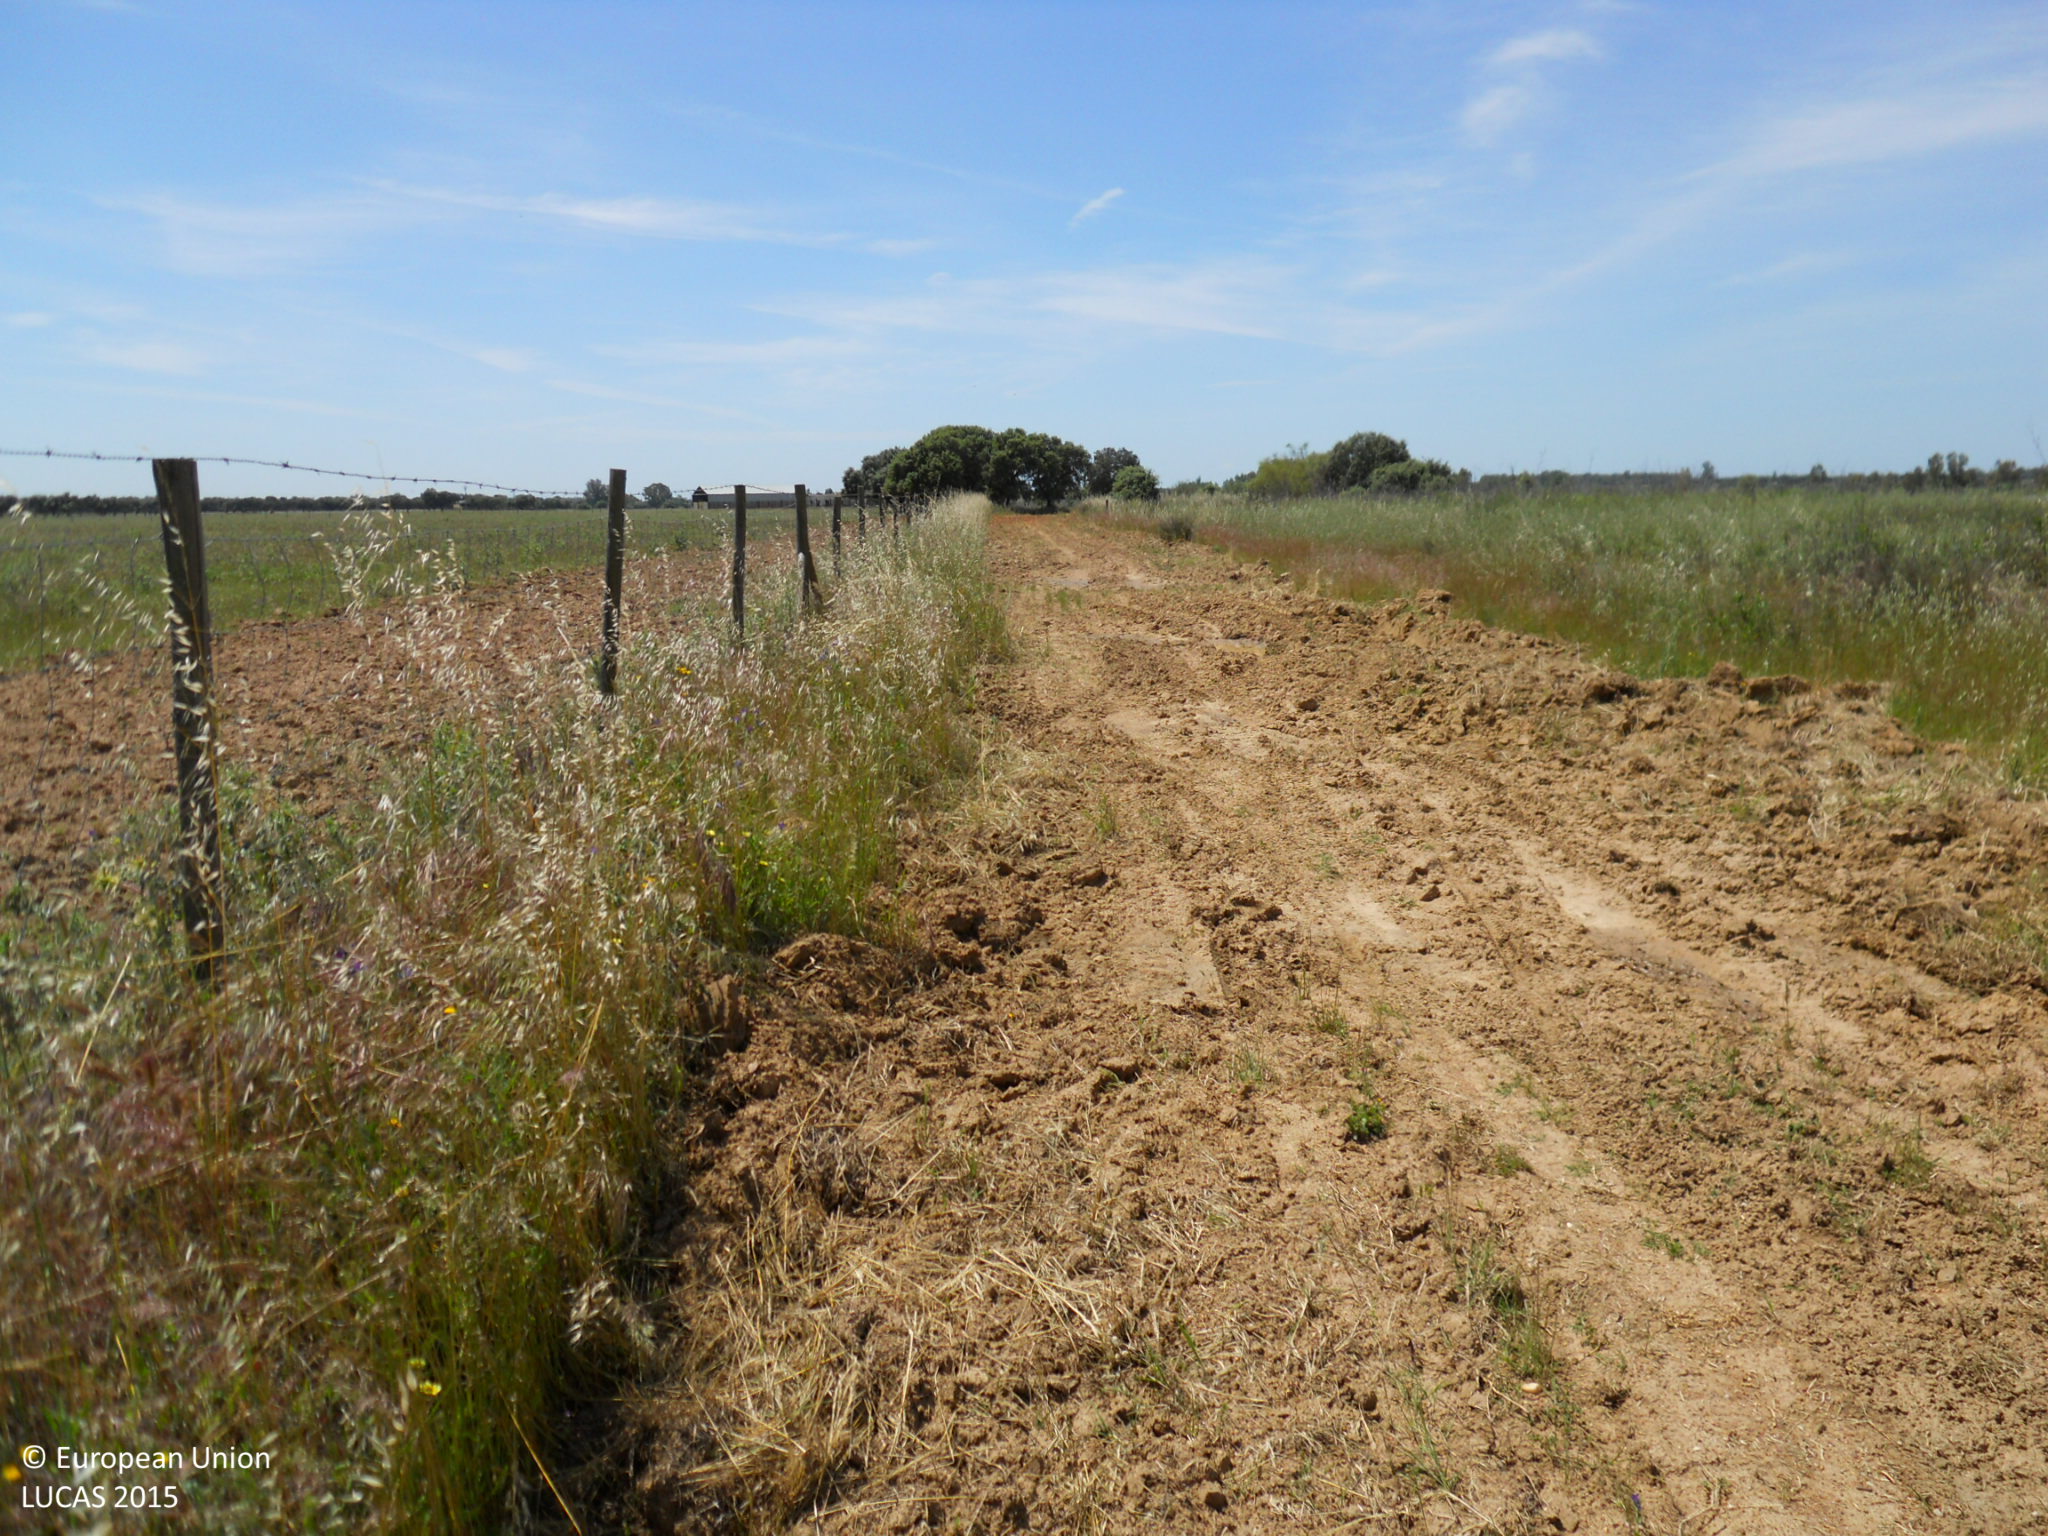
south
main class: Grassland
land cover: Grassland with sparse tree/shrub cover
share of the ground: > 75 %
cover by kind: herbaceous plants 95 %, broadleaved forest trees 5 %
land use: Agriculture (excluding fallow land and kitchen gardens)
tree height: > 5 m
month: April
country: ES
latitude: 39.0679
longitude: -6.8880
